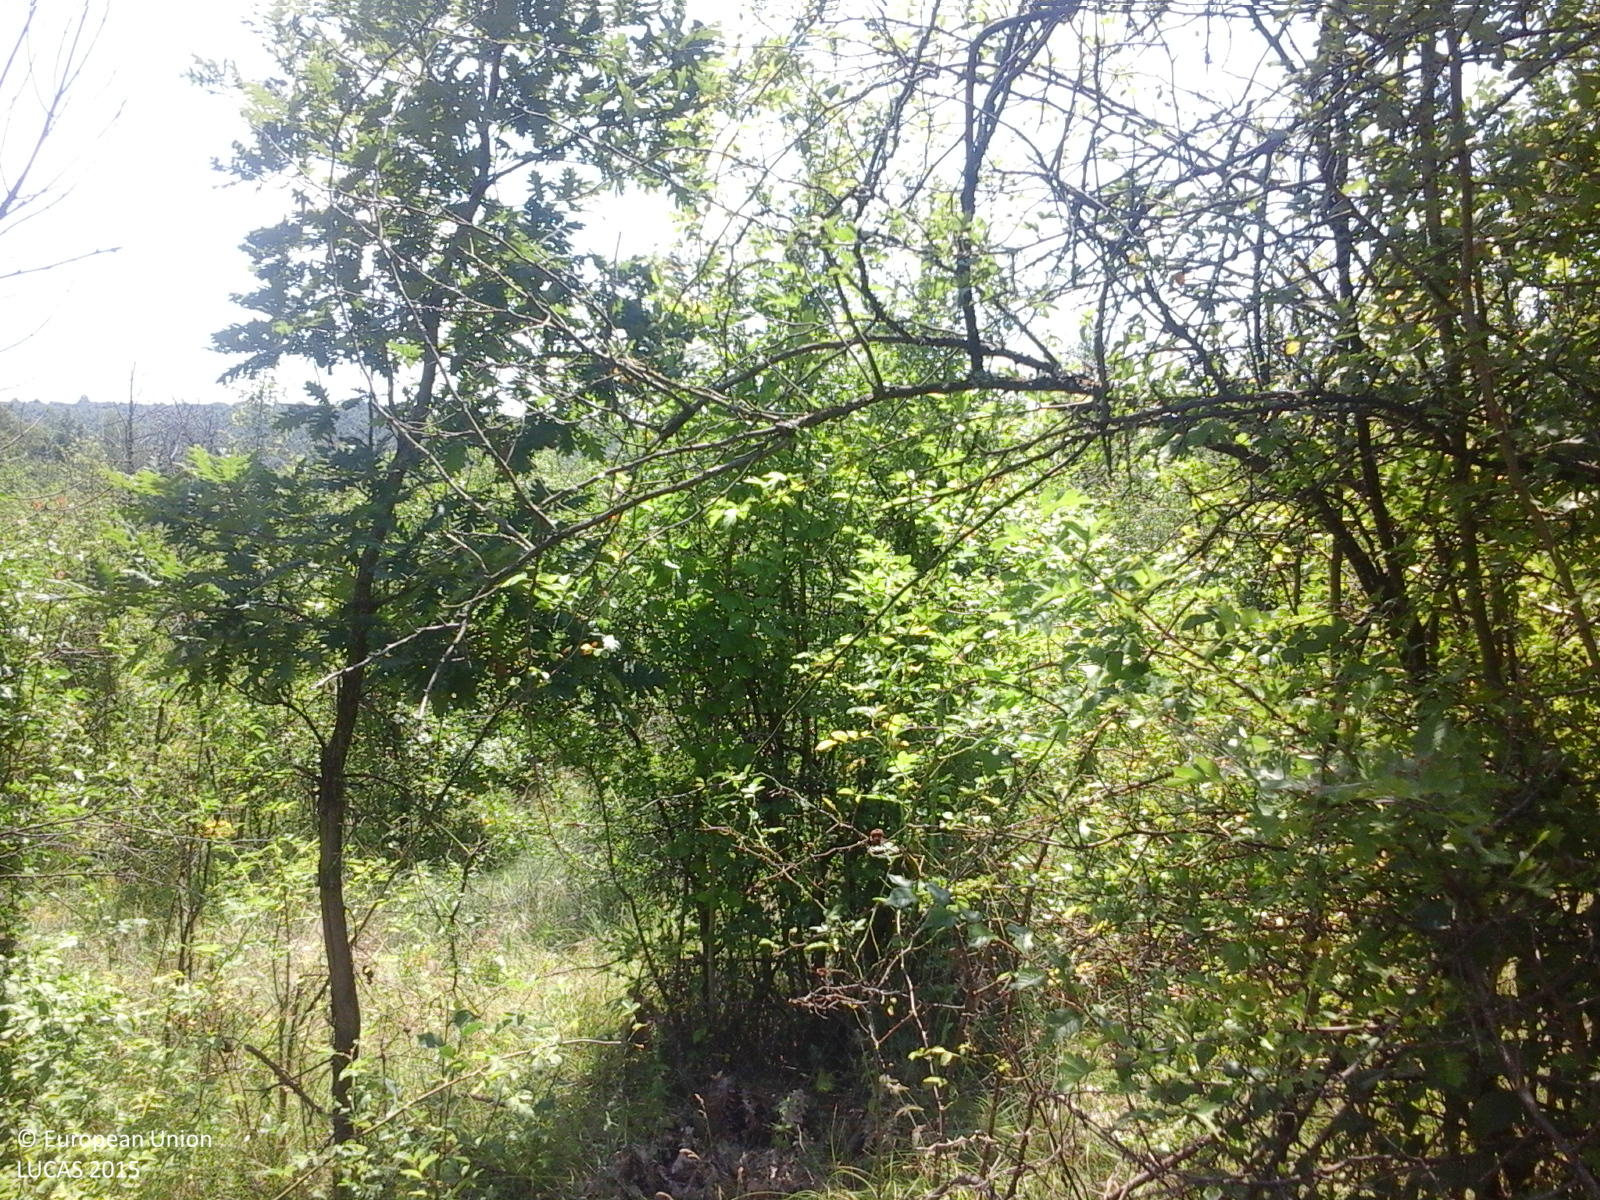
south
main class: Shrubland
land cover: Shrubland with sparse tree cover
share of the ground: > 75 %
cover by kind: shrubs 85 %, herbaceous plants 10 %, broadleaved forest trees 5 %
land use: Semi-natural and natural areas not in use
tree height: < 5 m
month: July
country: RO
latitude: 44.6737
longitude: 24.4136
